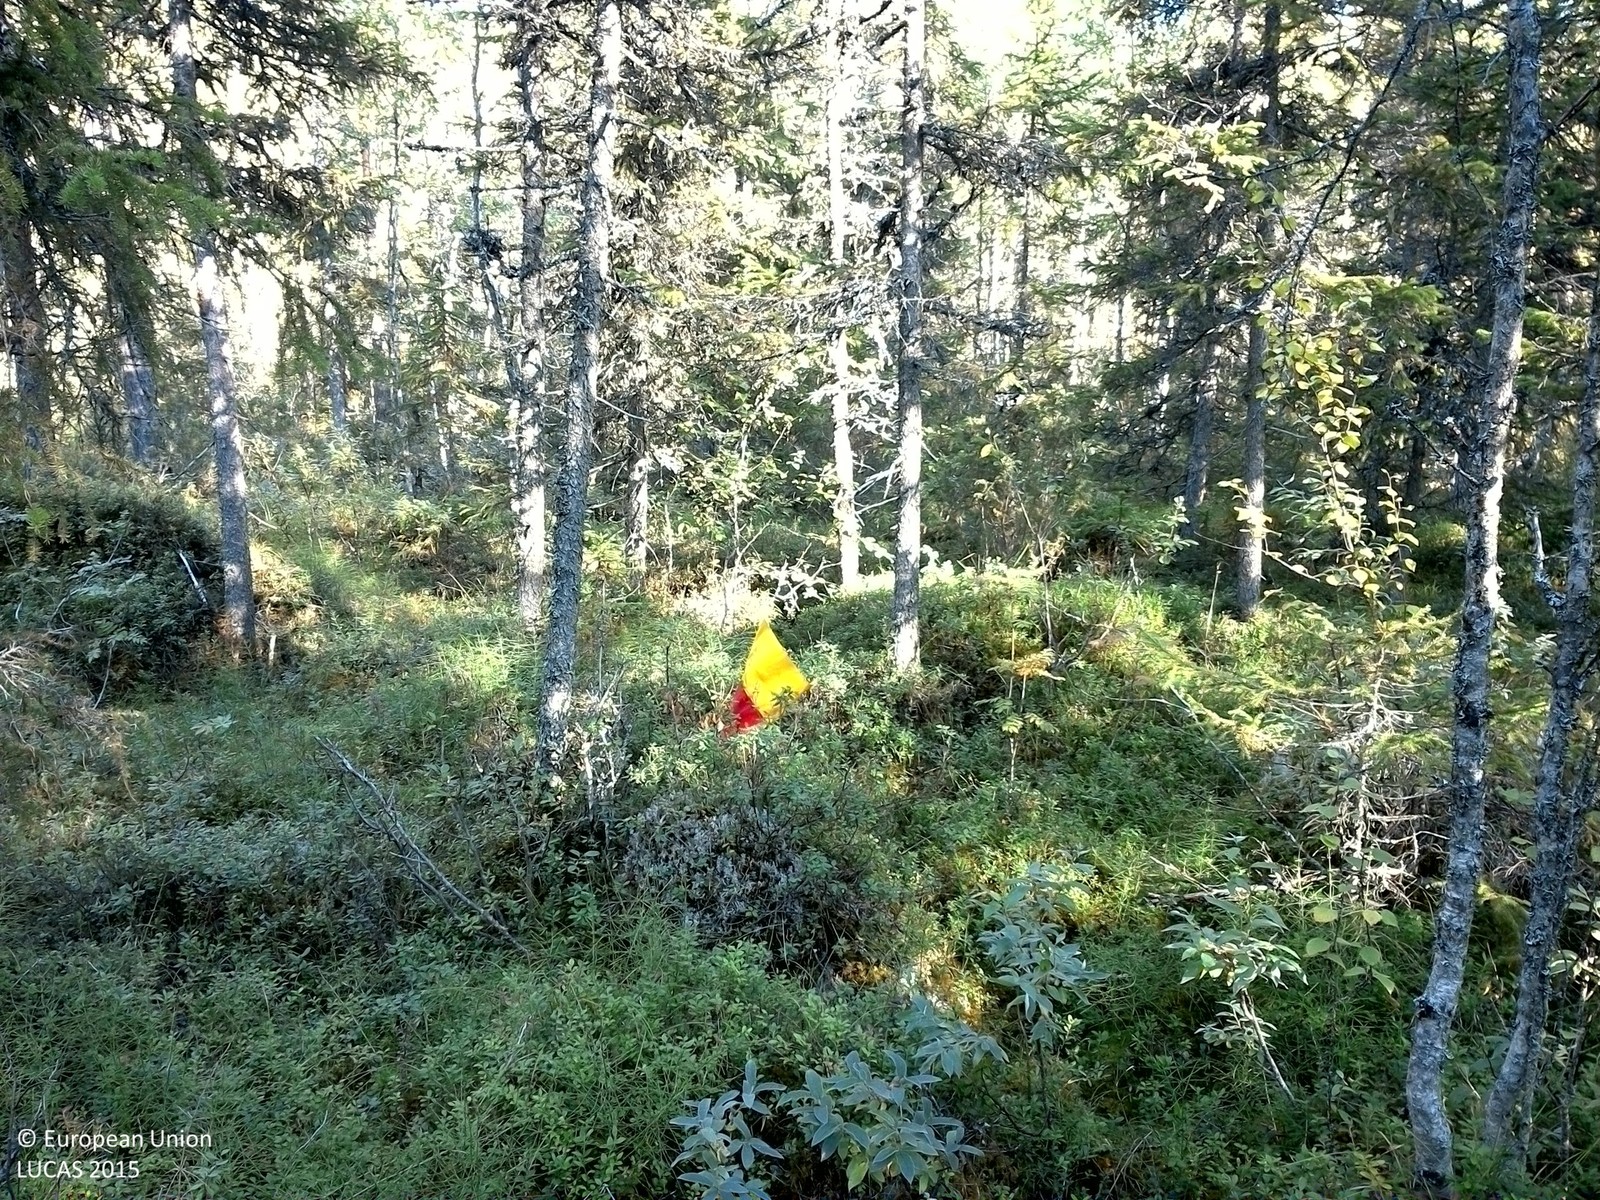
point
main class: Woodland
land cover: Other coniferous woodland
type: boreal forest
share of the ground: 50 - 75 %
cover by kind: coniferous forest trees 50 %, shrubs 35 %, lichens and mosses 10 %, broadleaved forest trees 5 %
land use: Forestry
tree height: > 5 m
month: September
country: SE
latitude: 63.8594
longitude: 16.6647
